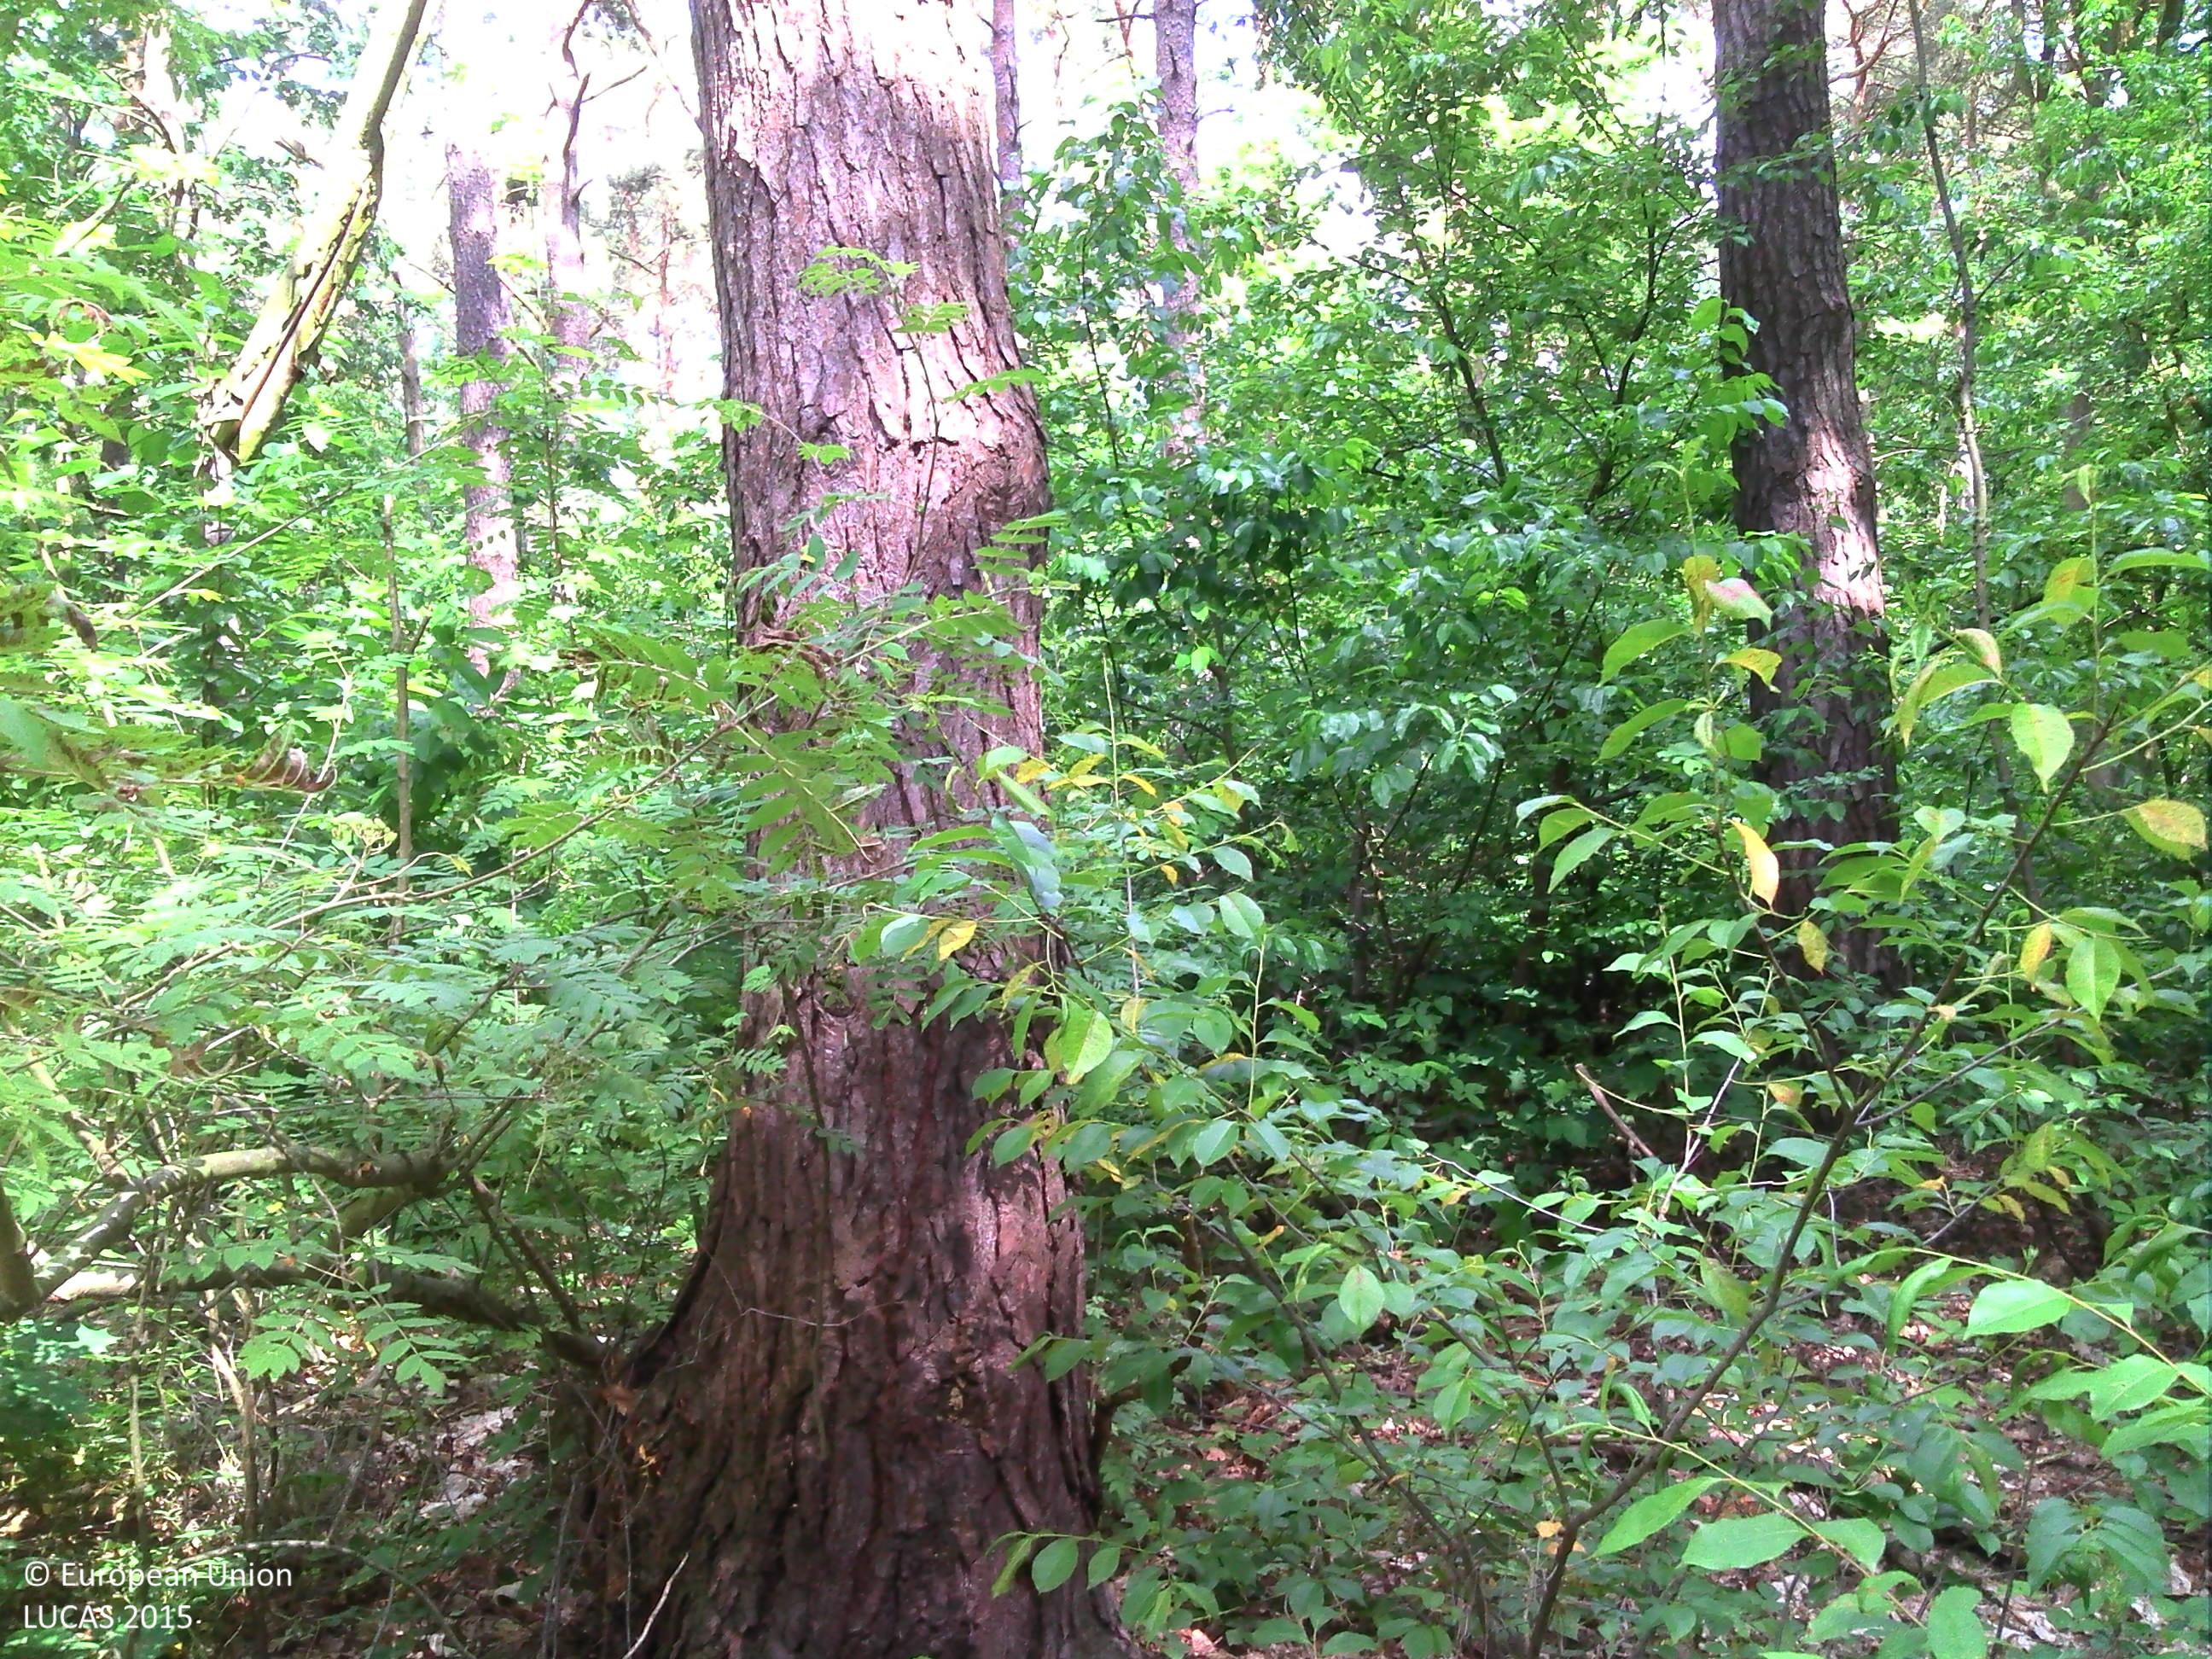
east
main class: Woodland
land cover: Pine dominated mixed woodland
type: exotic forest
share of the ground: > 75 %
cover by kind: broadleaved forest trees 70 %, coniferous forest trees 25 %, herbaceous plants 5 %
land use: Forestry
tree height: > 5 m
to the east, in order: Pine dominated mixed woodland; Tracks; Pine dominated mixed woodland
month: June
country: BE
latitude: 51.0756
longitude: 5.7023
